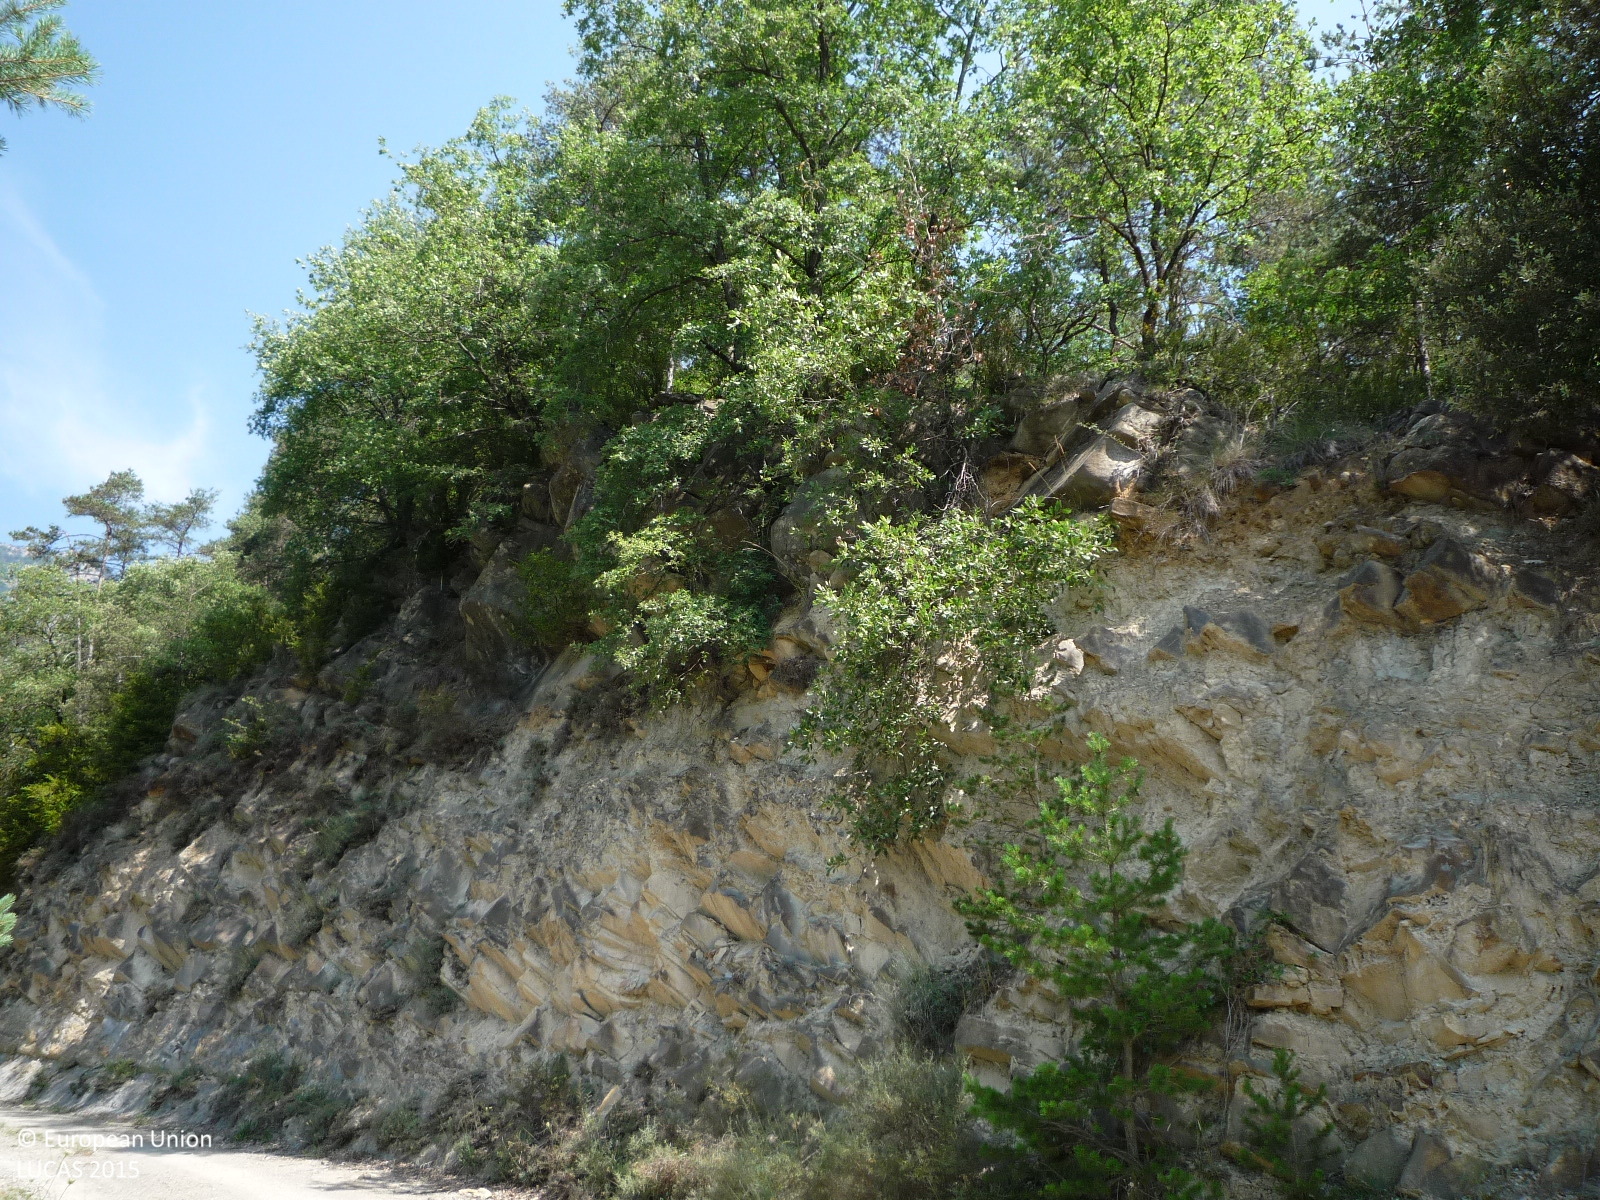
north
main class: Woodland
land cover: Pine dominated mixed woodland
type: coniferous forest of the mediterranean region
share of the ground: > 75 %
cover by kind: coniferous forest trees 55 %, broadleaved forest trees 45 %
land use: Semi-natural and natural areas not in use
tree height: > 5 m
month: July
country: ES
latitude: 42.1710
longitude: 1.9628
